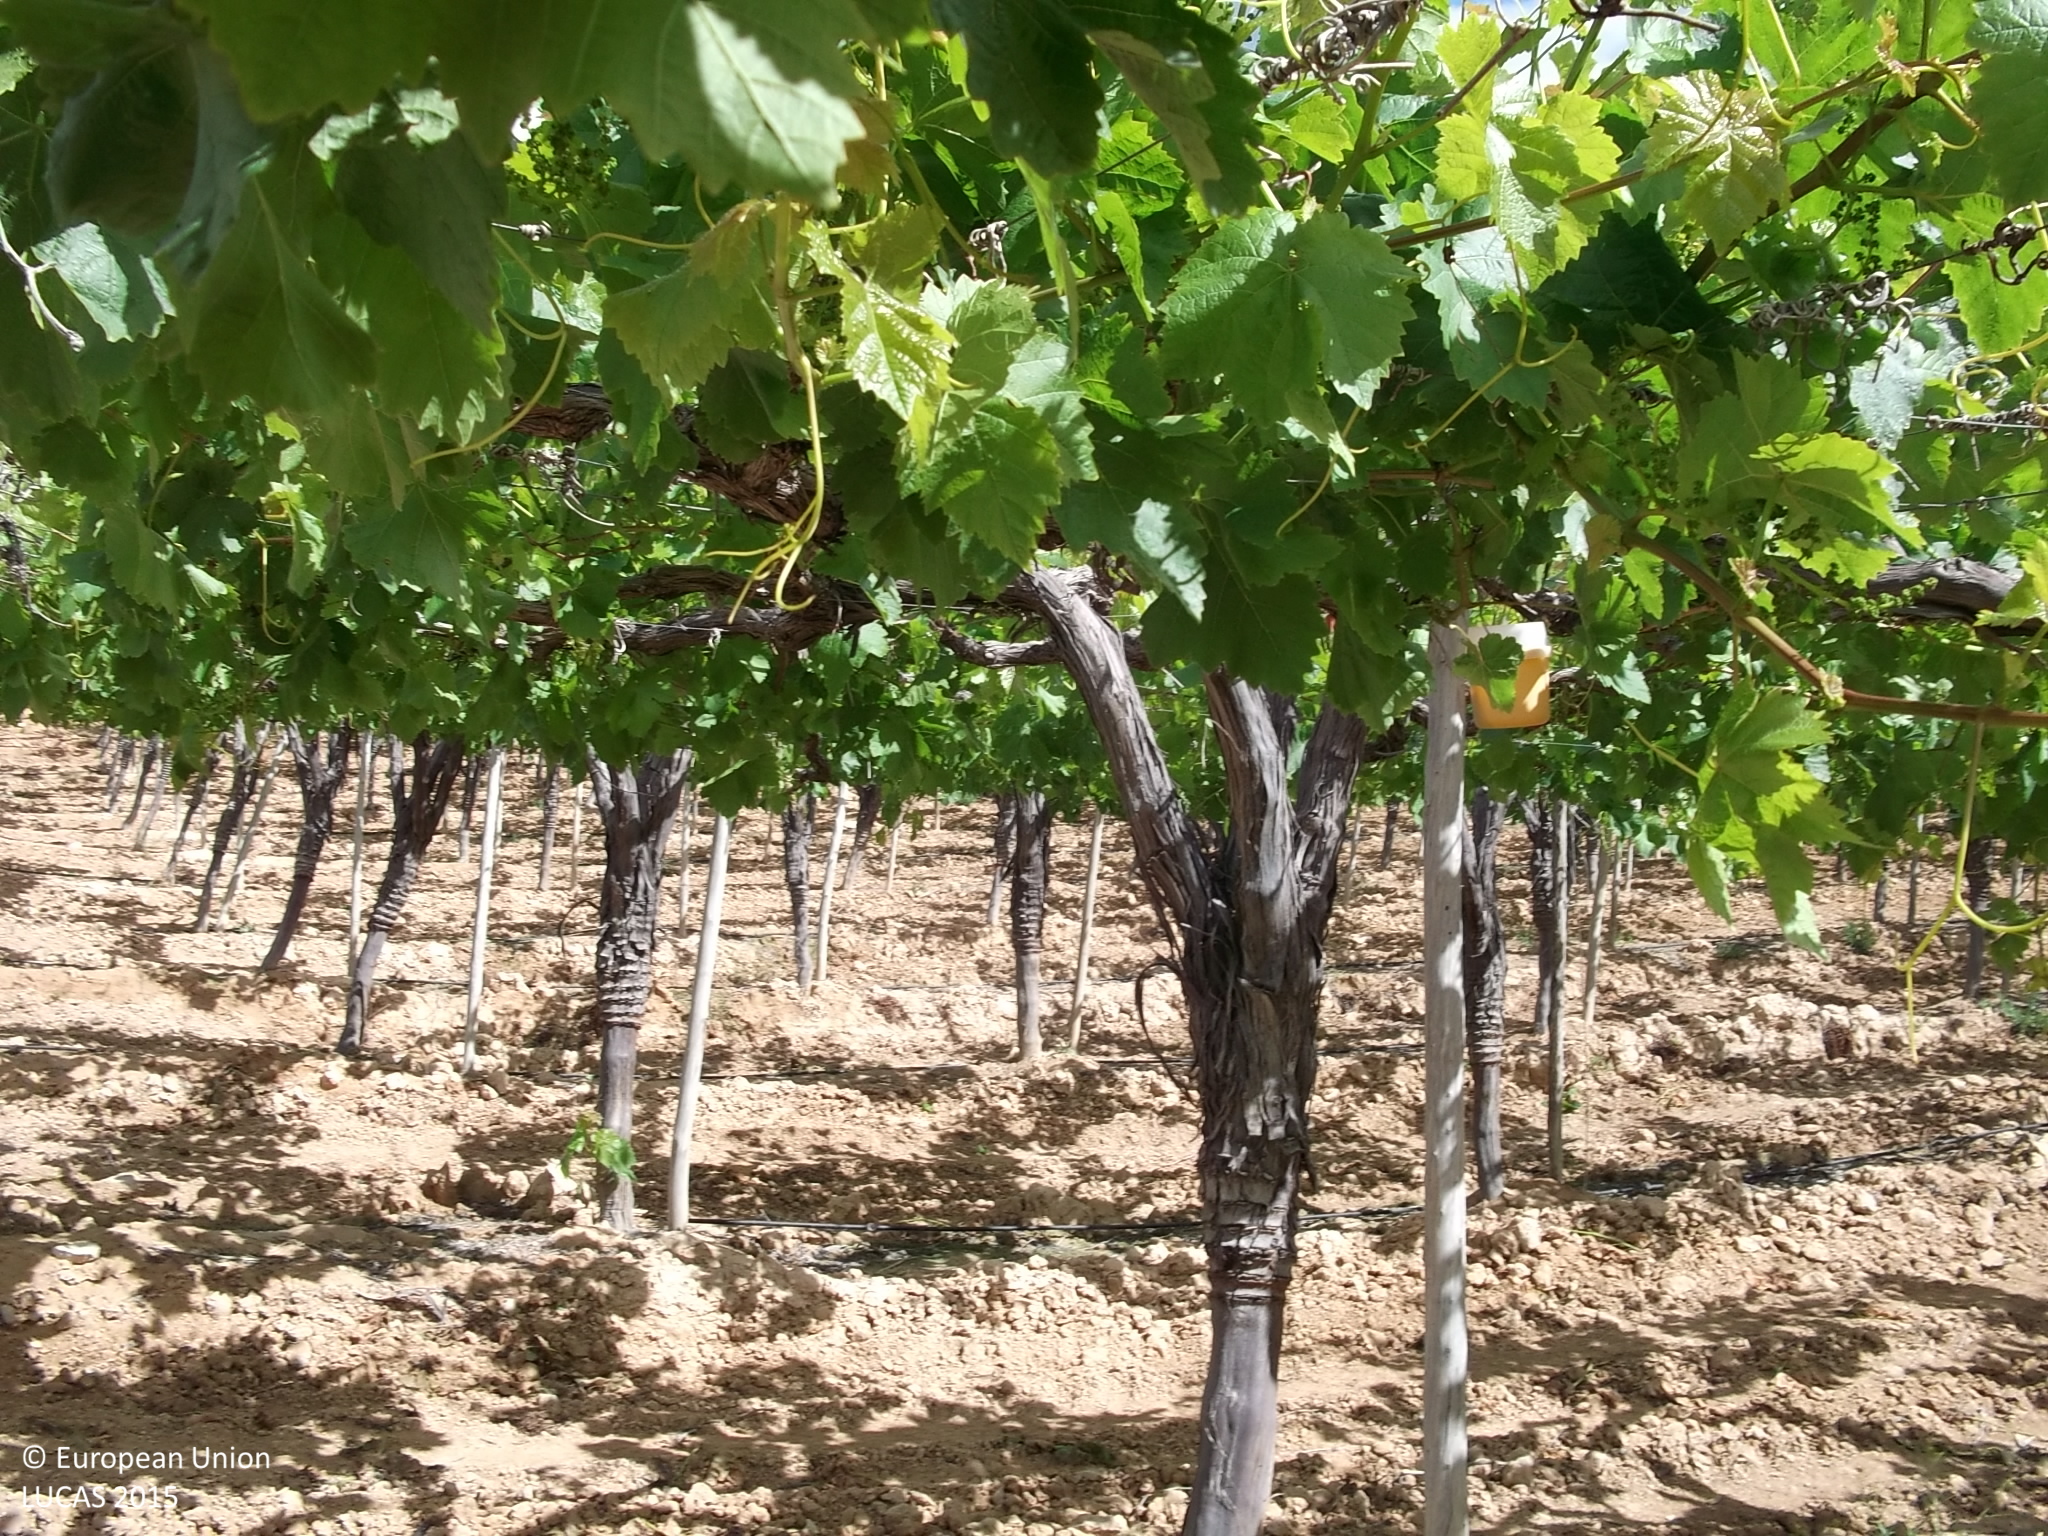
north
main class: Cropland
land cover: Vineyards
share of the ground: > 75 %
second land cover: Other bare soil
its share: > 75 %
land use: Agriculture (excluding fallow land and kitchen gardens)
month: April
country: ES
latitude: 38.2742
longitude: -1.3391
